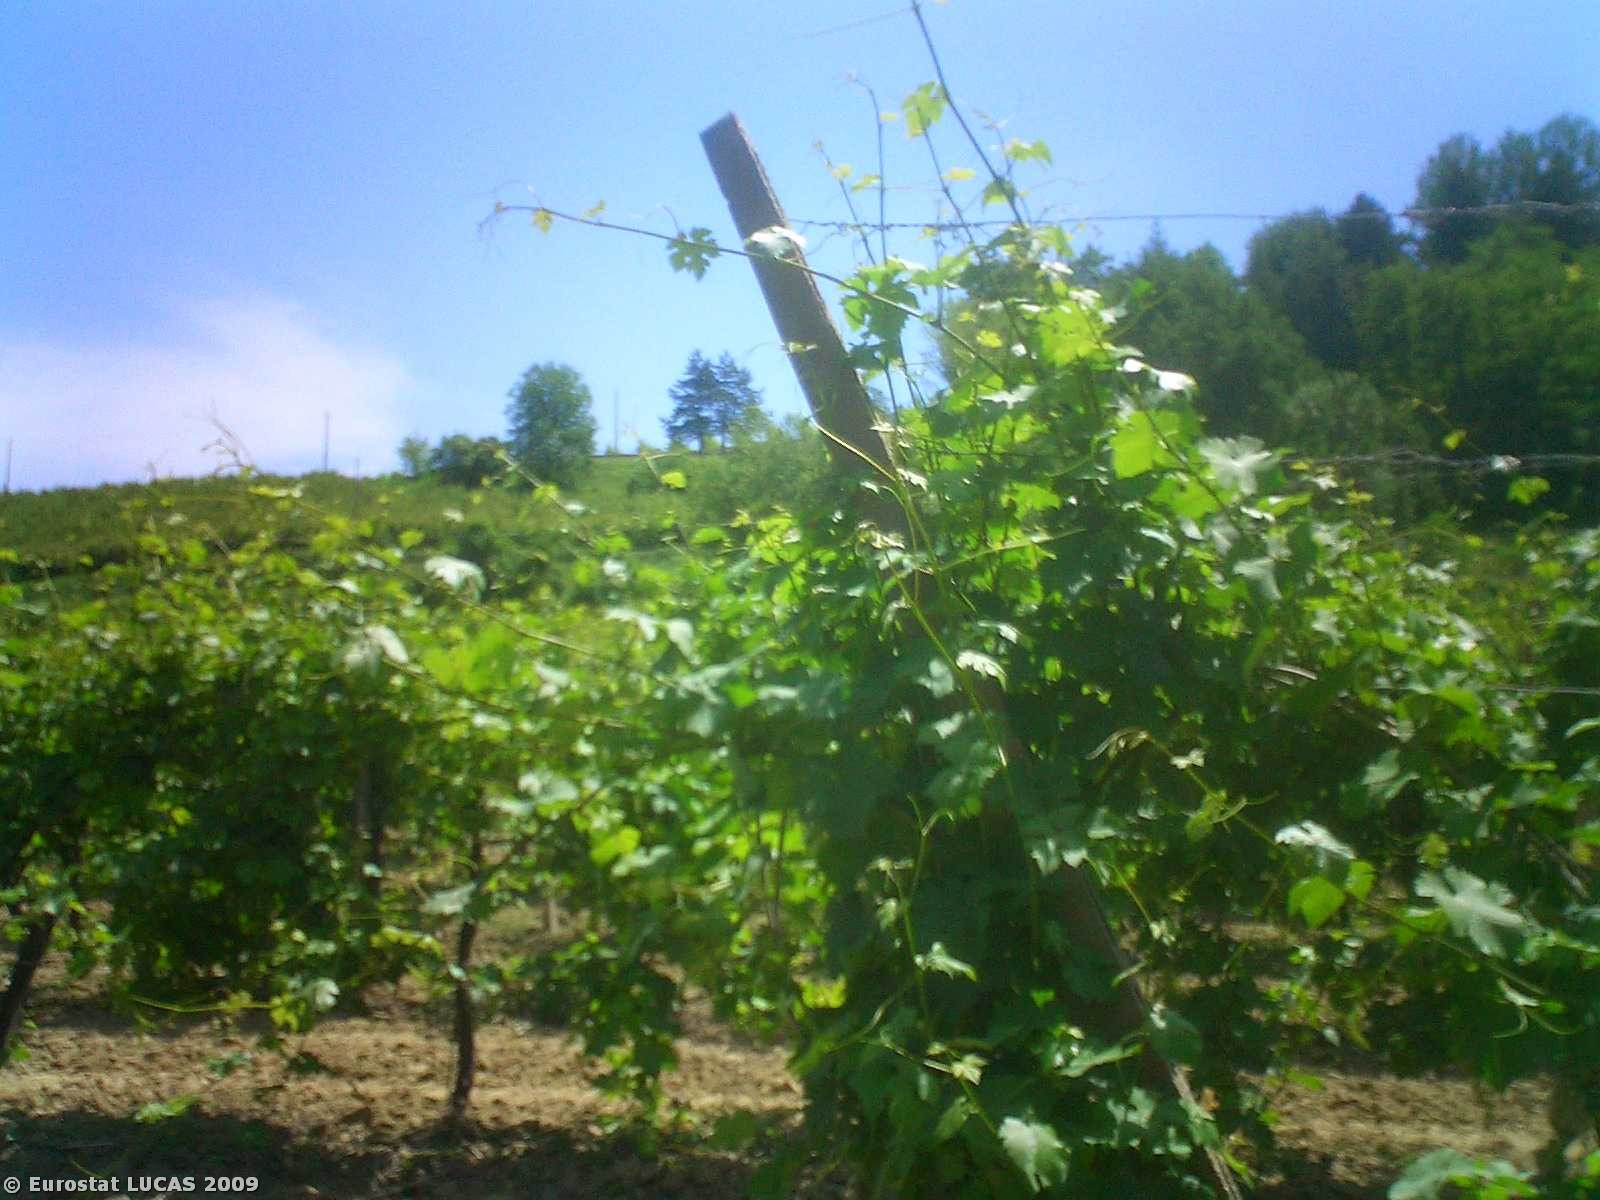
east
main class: Woodland
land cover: Mixed woodland
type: mesophytic deciduous forest
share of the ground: 50 - 75 %
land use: Forestry
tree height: > 5 m
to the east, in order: Mixed woodland; Grassland without tree/shrub cover; Mixed woodland; Vineyards; Grassland with sparse tree/shrub cover; Other fruit trees and berries; Grassland with sparse tree/shrub cover; Vineyards; Grassland with sparse tree/shrub cover
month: May
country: IT
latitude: 44.2294
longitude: 11.6362
